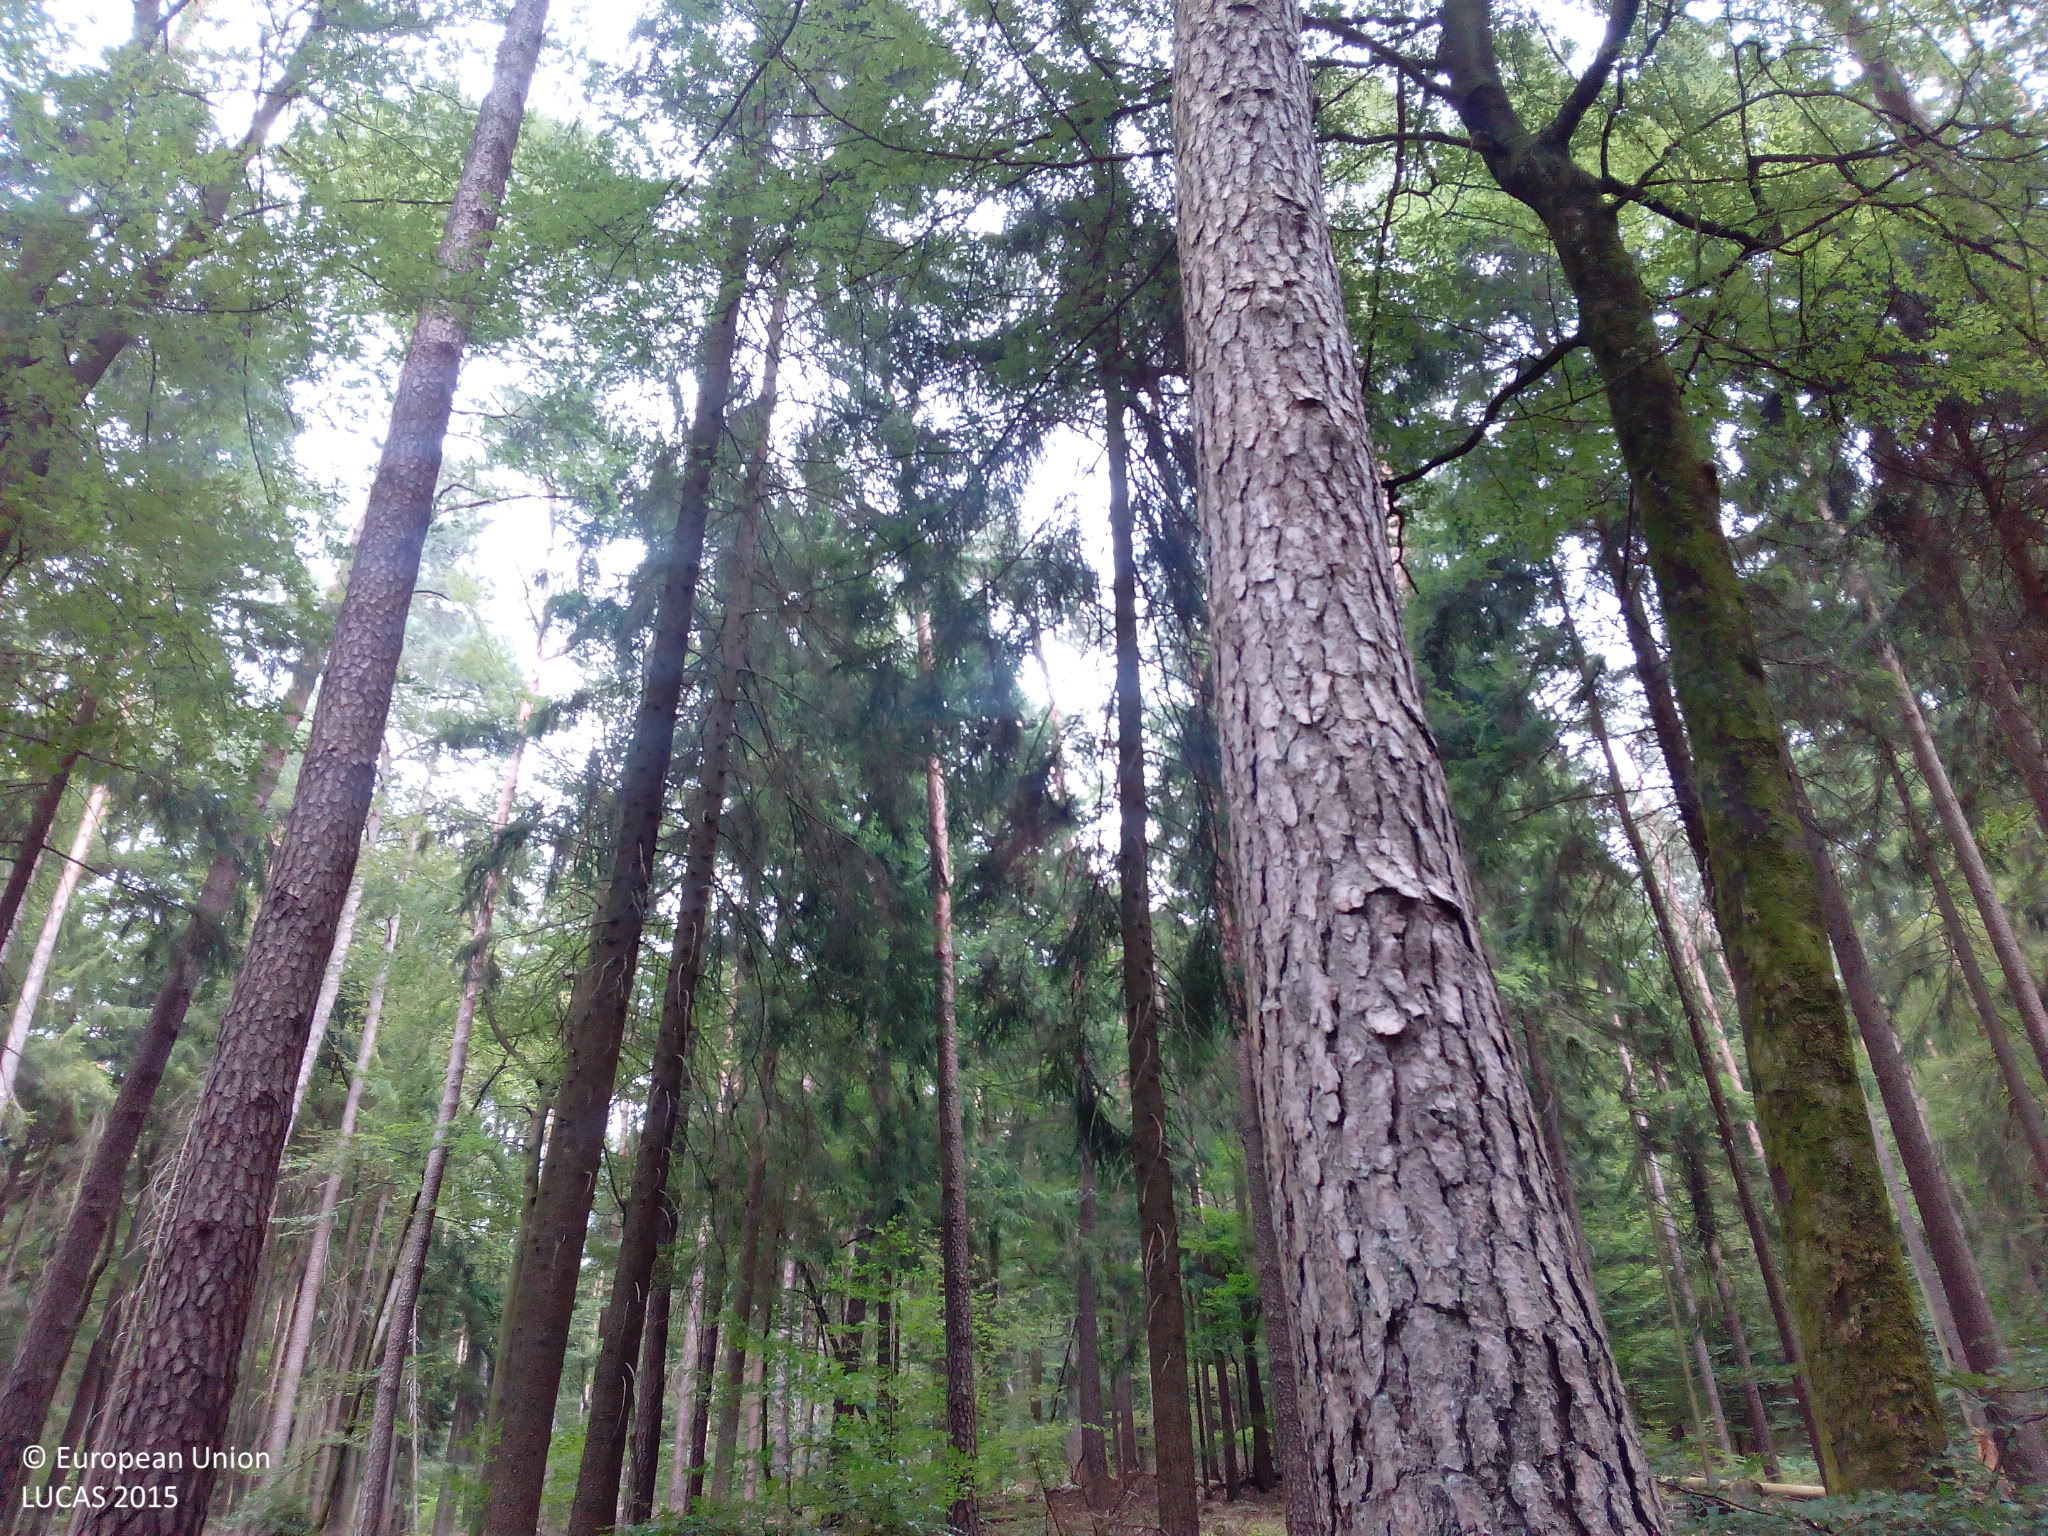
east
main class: Woodland
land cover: Other mixed woodland
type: hemiboreal forest and nemoral coniferous forest and mixed broadleaved-coniferous forest
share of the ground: > 75 %
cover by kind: coniferous forest trees 60 %, broadleaved forest trees 25 %, unconsolidated bare surface 10 %, herbaceous plants 5 %
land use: Forestry
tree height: > 5 m
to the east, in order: Spruce dominated mixed woodland; Tracks; Broadleaved woodland; Tracks; Broadleaved woodland
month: July
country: DE
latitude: 49.1155
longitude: 7.6030
